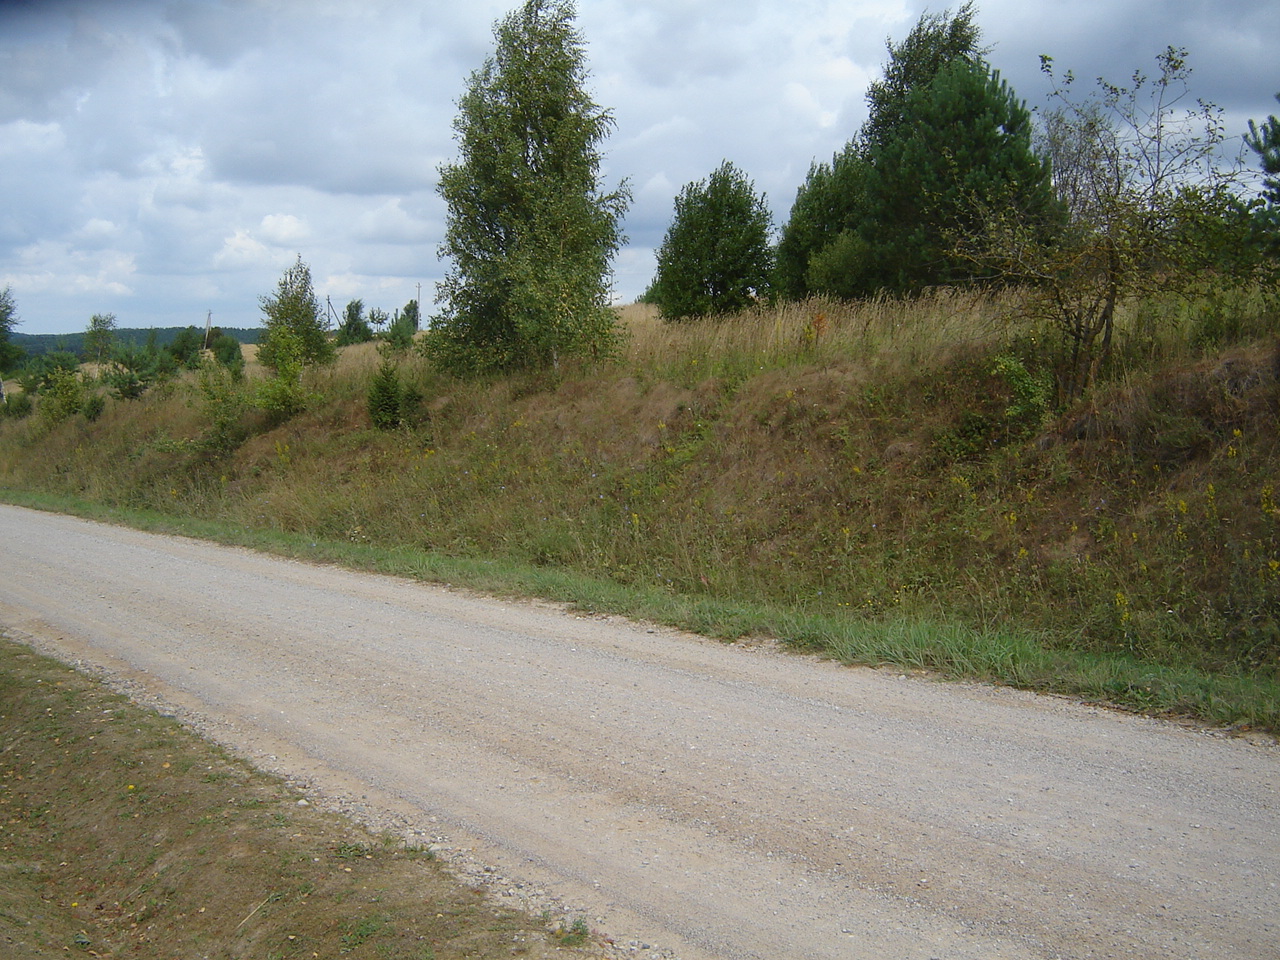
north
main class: Woodland
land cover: Pine dominated coniferous woodland
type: hemiboreal forest and nemoral coniferous forest and mixed broadleaved-coniferous forest
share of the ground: 50 - 75 %
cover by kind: coniferous forest trees 50 %, herbaceous plants 40 %, broadleaved forest trees 5 %, shrubs 5 %
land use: Residential
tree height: > 5 m
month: August
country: LT
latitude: 54.6191
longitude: 24.7114
